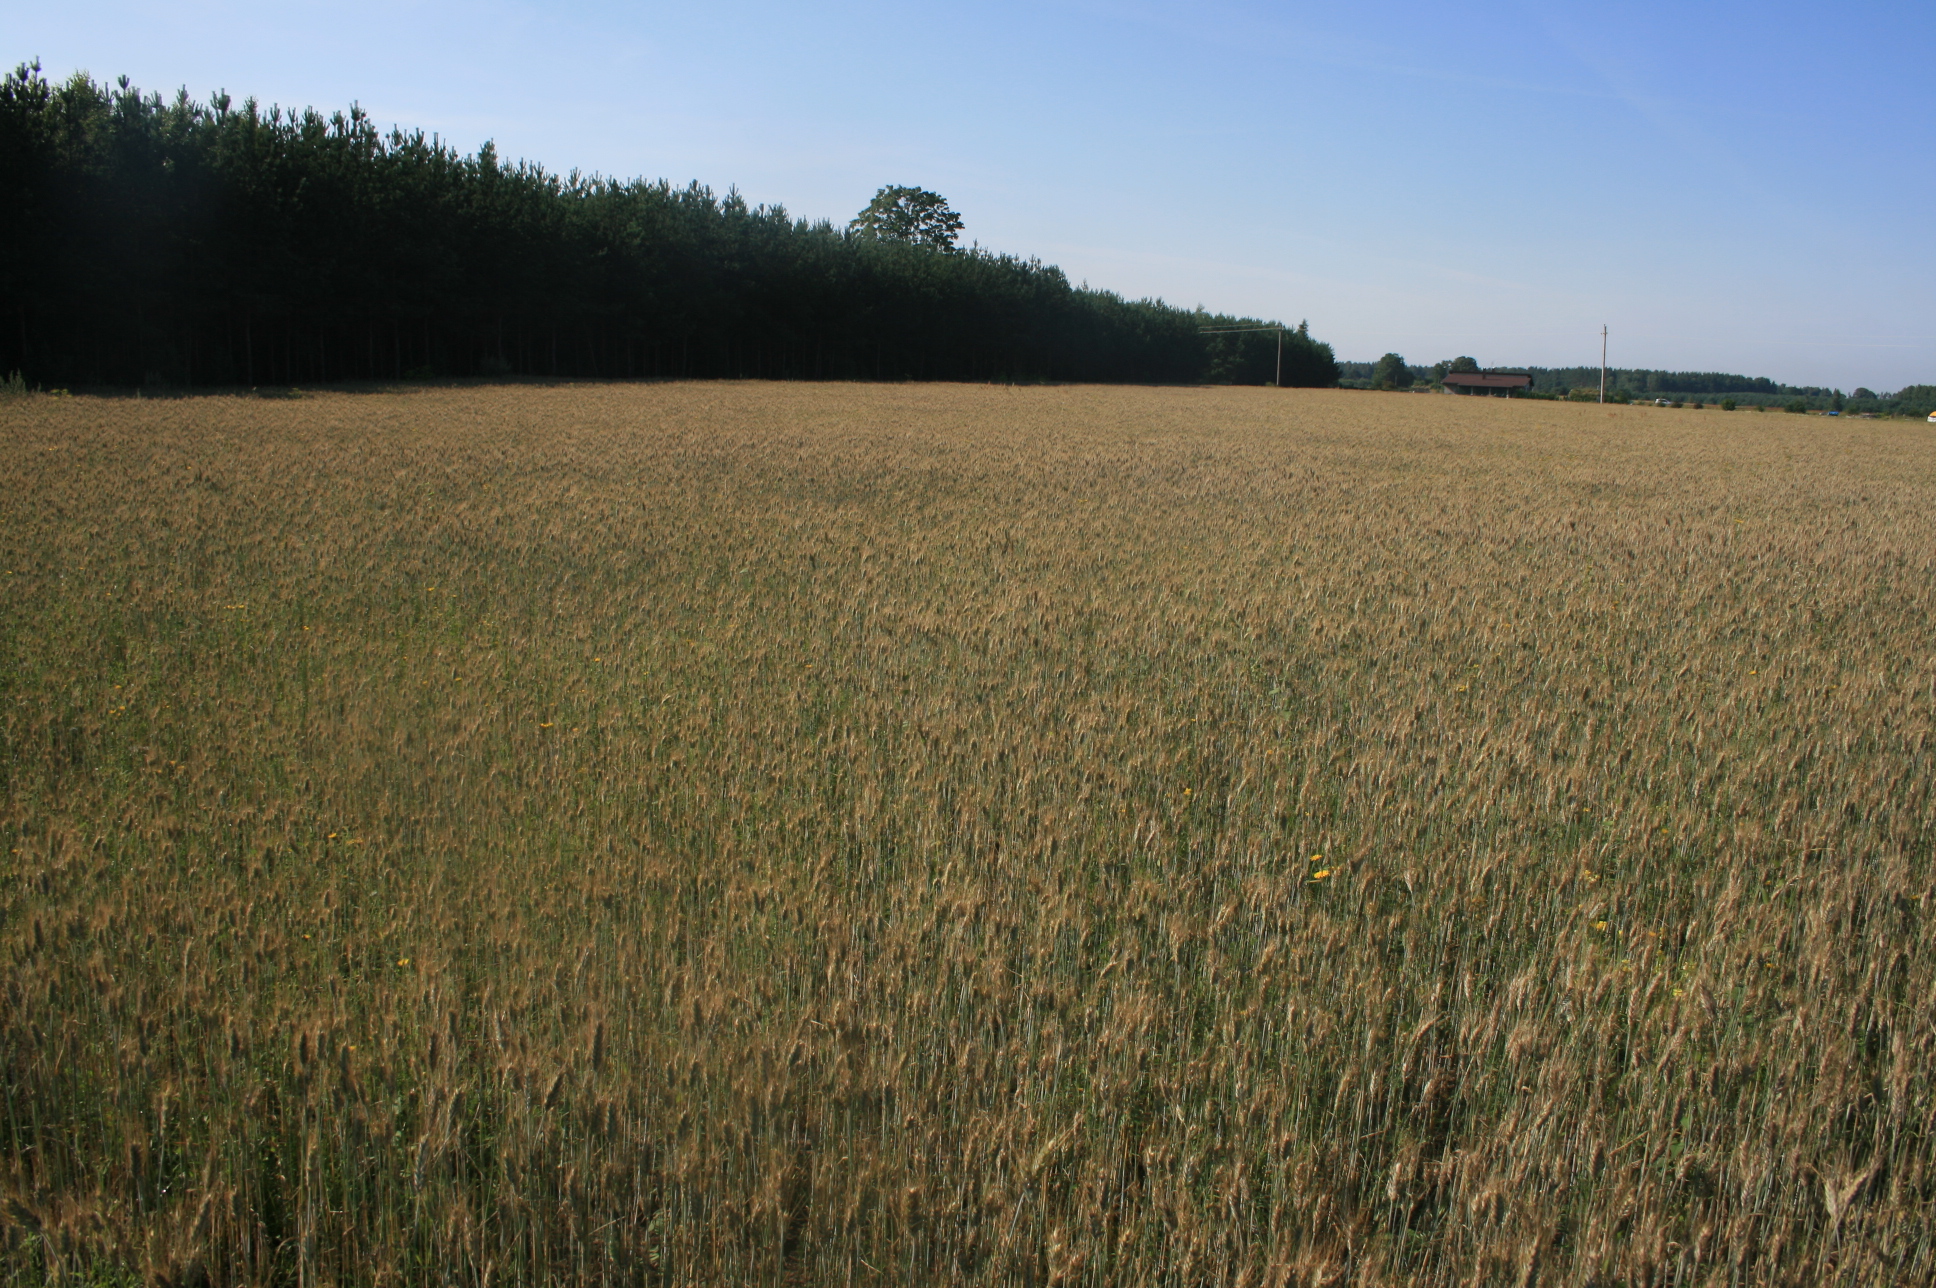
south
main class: Cropland
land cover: Common wheat
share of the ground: > 75 %
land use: Agriculture (excluding fallow land and kitchen gardens)
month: August
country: LT
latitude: 55.6263
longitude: 21.3672
